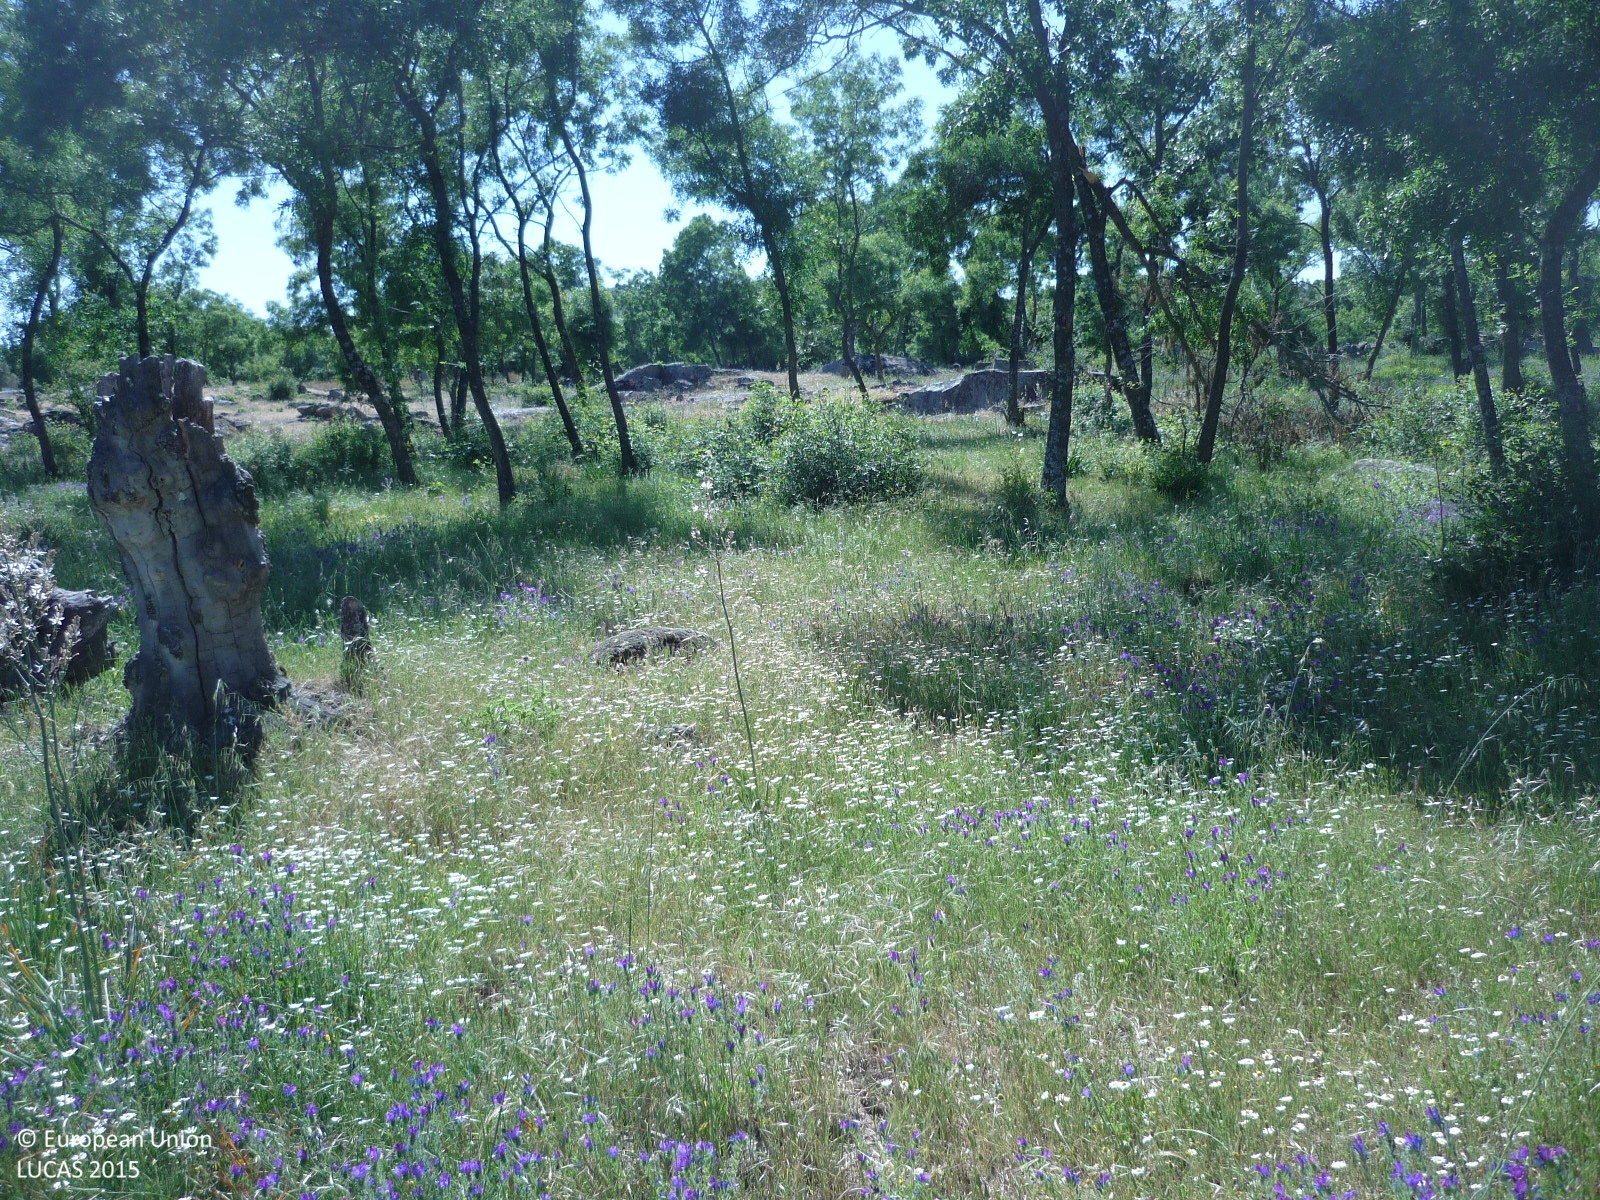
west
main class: Woodland
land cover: Broadleaved woodland
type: thermophilous deciduous forest
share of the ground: 50 - 75 %
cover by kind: broadleaved forest trees 70 %, herbaceous plants 20 %, shrubs 10 %
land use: Forestry
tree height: < 5 m
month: May
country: ES
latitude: 40.7091
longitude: -3.9768
